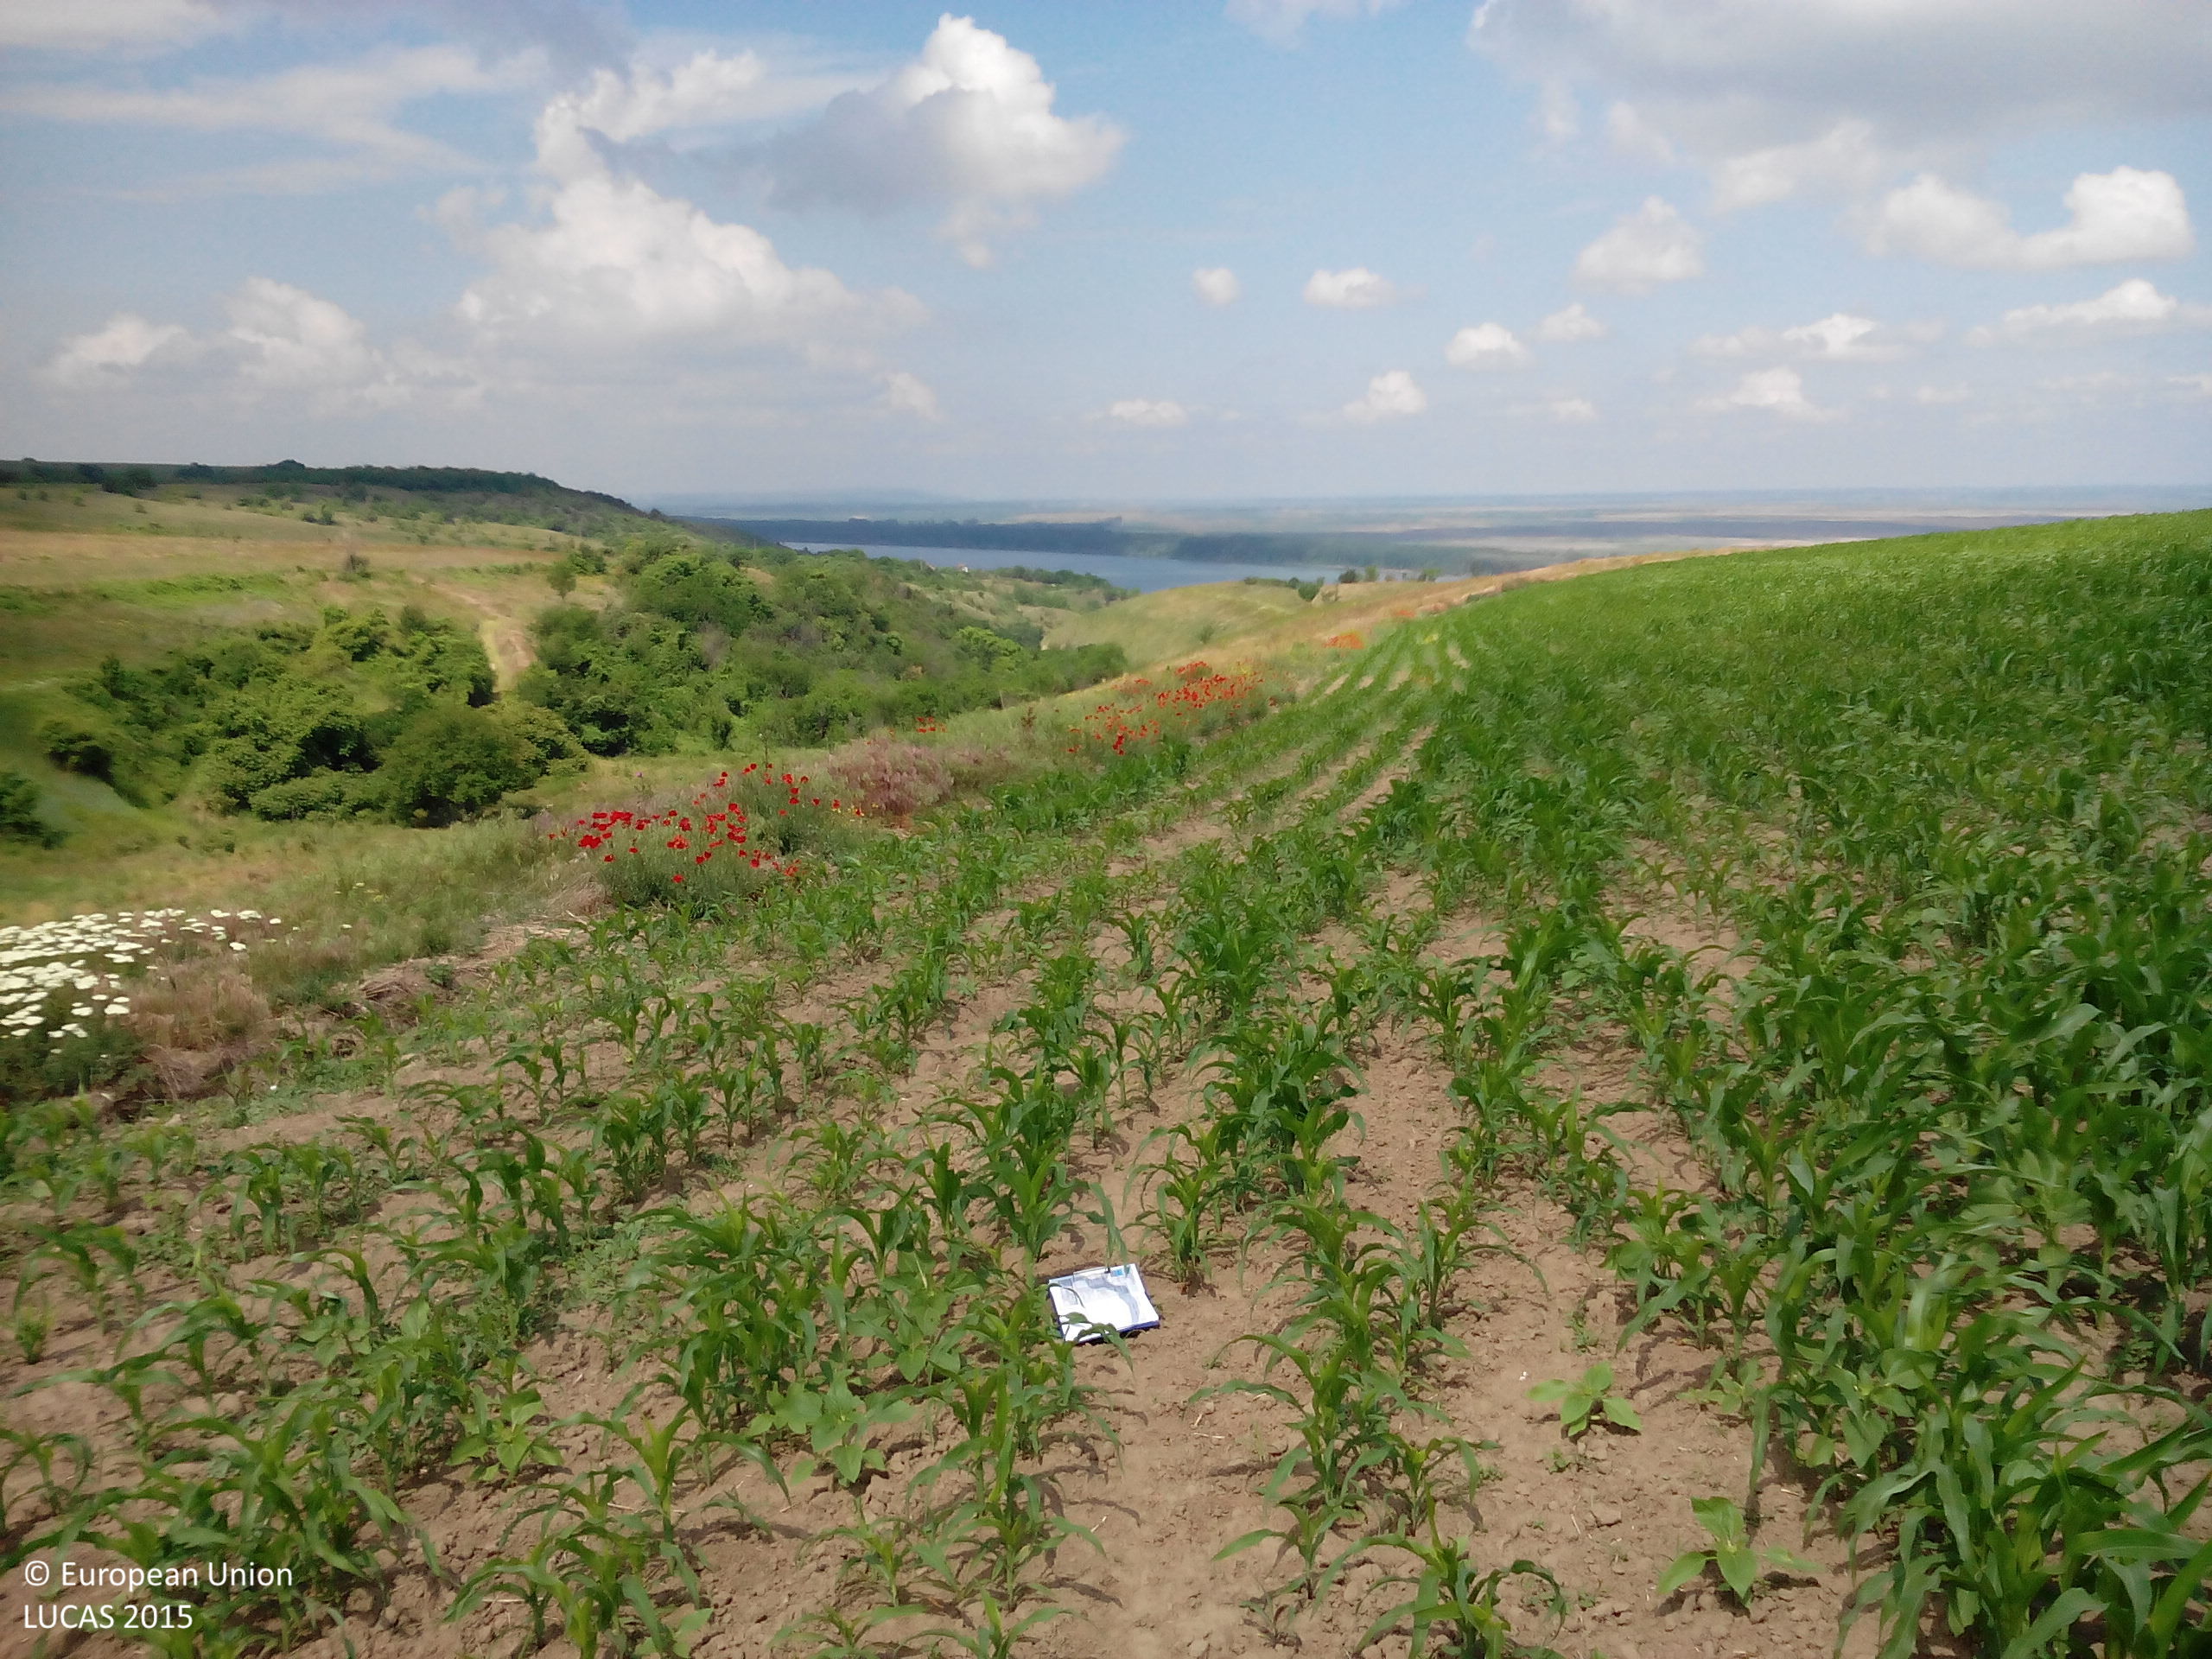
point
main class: Cropland
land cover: Maize
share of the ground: 25 - 50 %
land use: Agriculture (excluding fallow land and kitchen gardens)
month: May
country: BG
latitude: 43.6851
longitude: 24.2886
